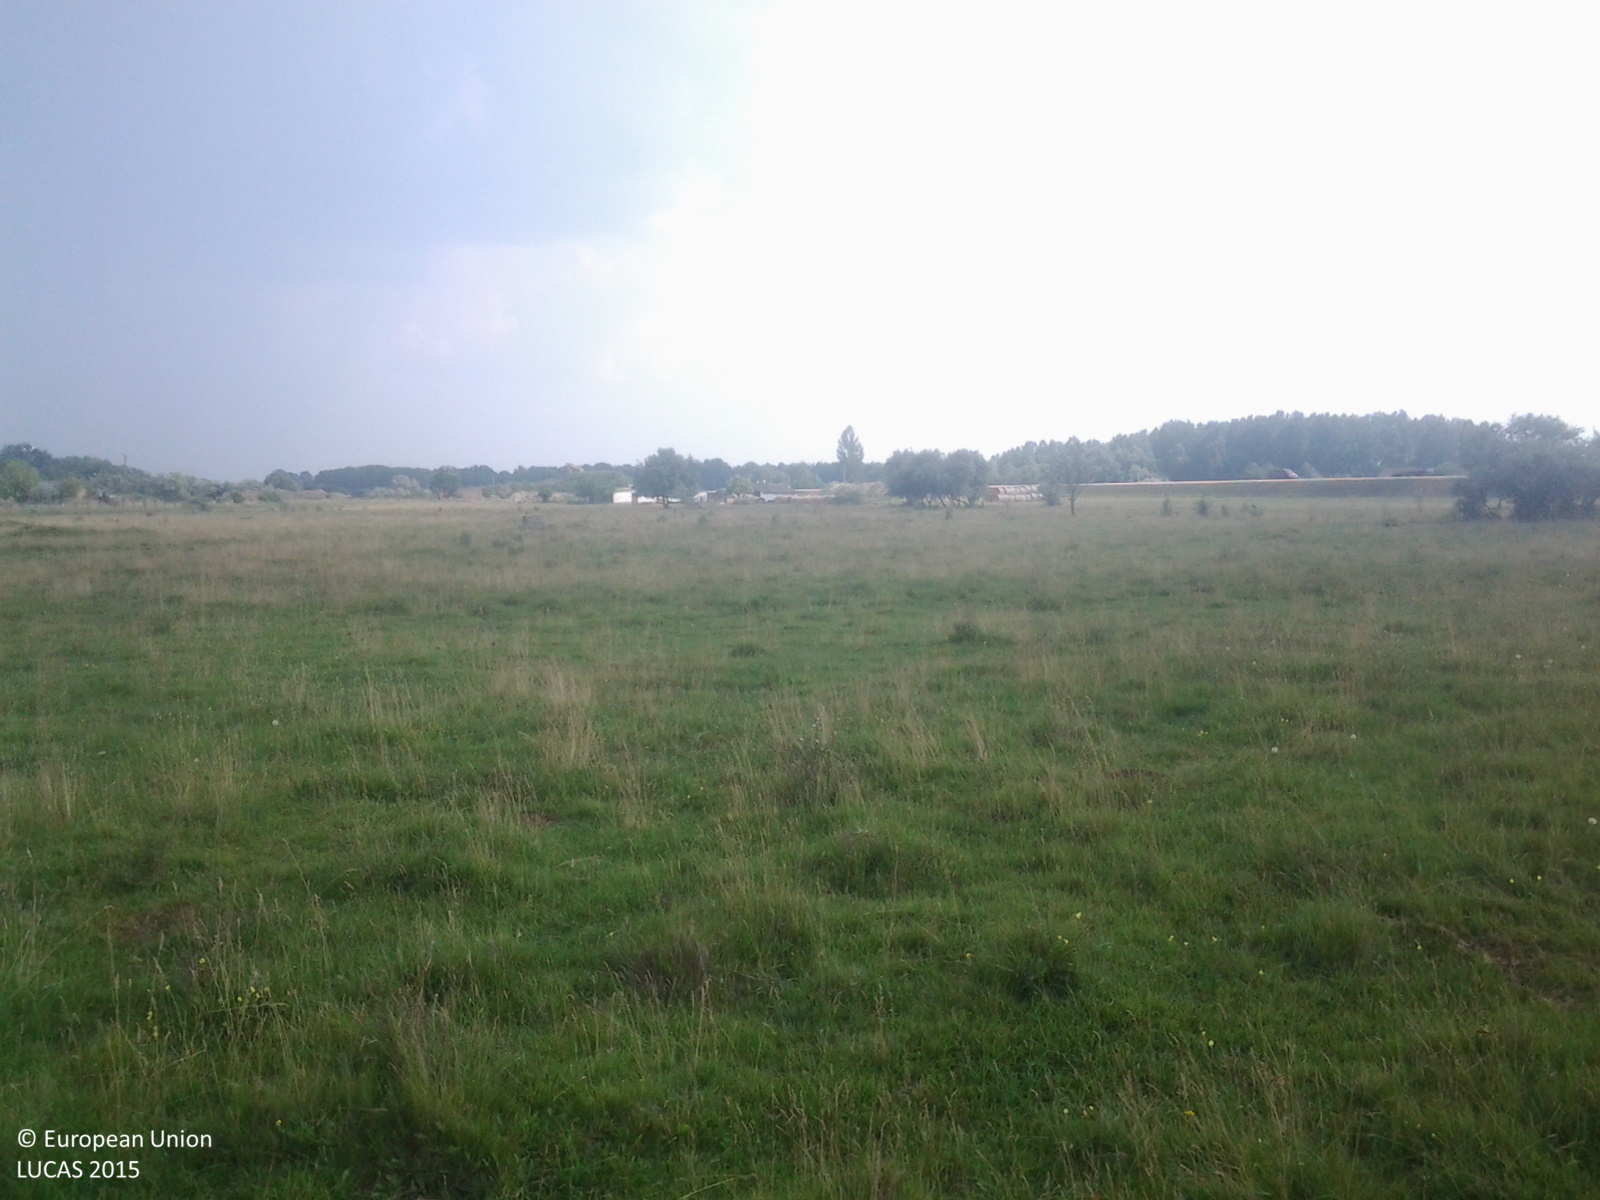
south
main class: Grassland
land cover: Grassland without tree/shrub cover
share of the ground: > 75 %
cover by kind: herbaceous plants 100 %
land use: Agriculture (excluding fallow land and kitchen gardens)
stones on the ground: < 10 %
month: June
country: HU
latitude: 46.9225
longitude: 19.7258
